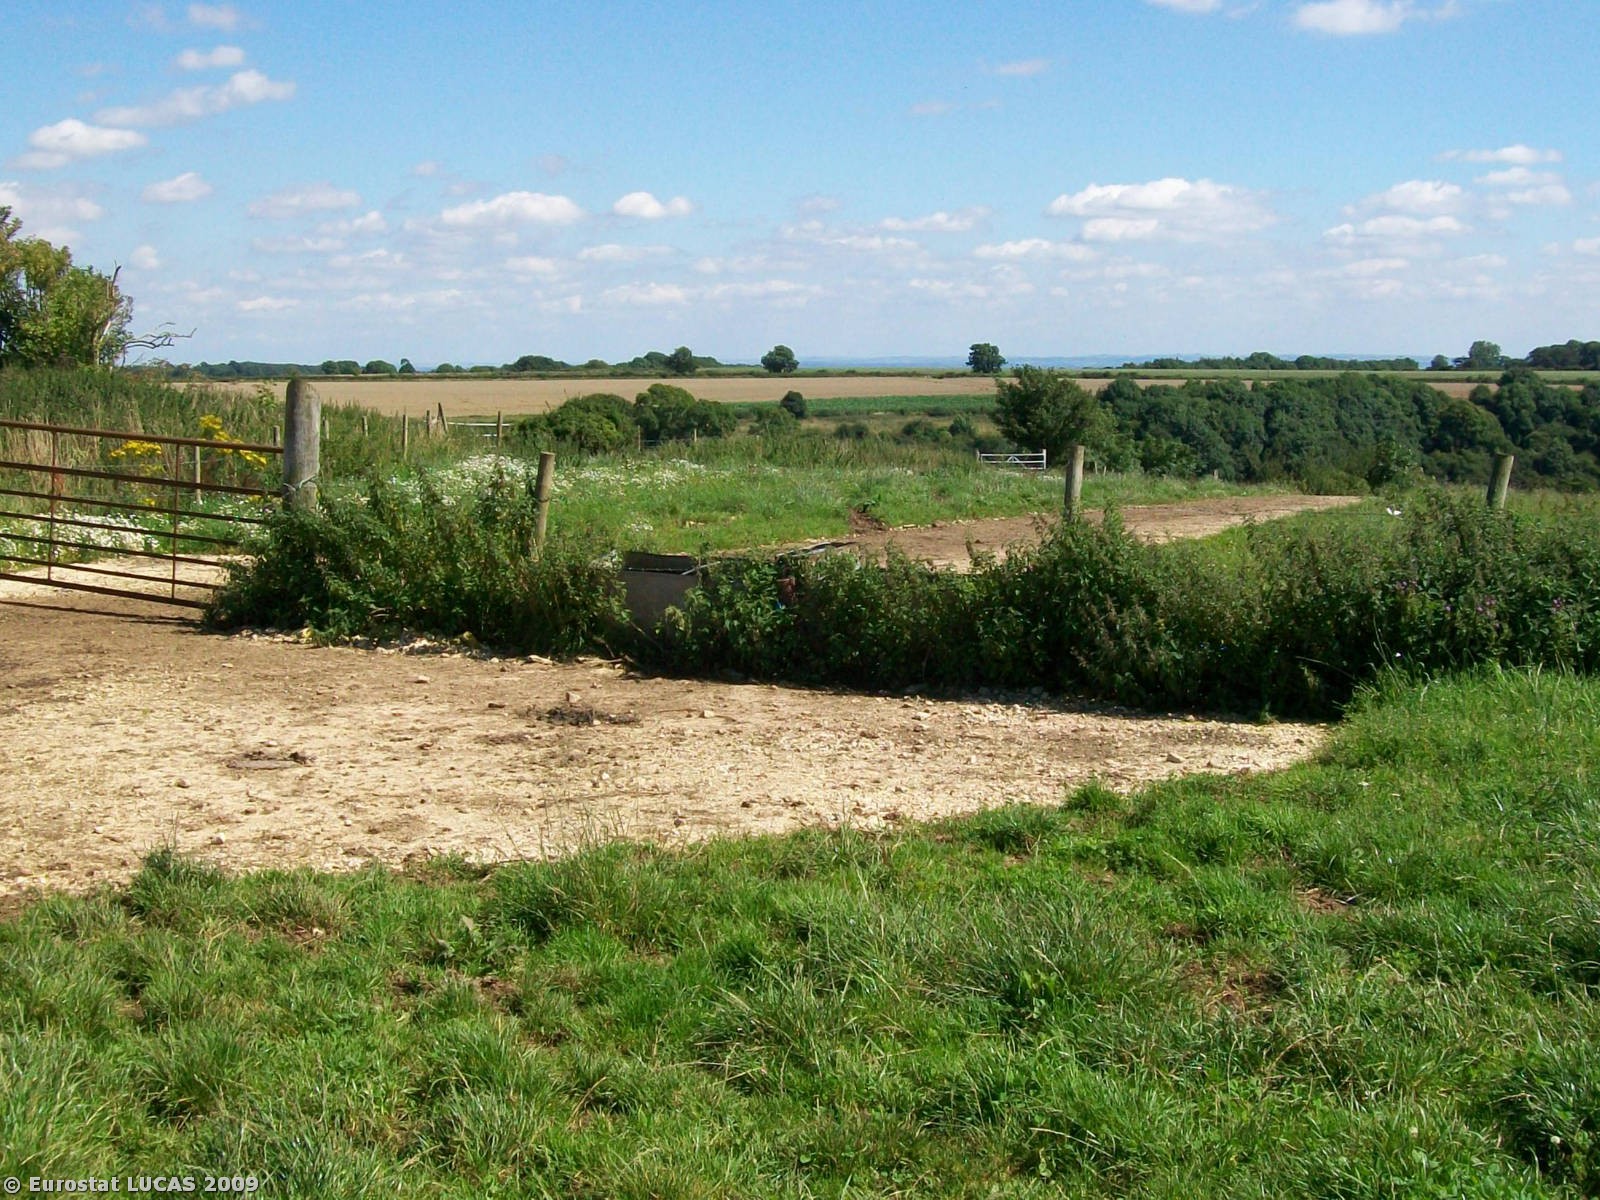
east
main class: Grassland
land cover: Grassland without tree/shrub cover
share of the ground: > 75 %
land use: Agriculture (excluding fallow land and kitchen gardens)
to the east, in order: Grassland without tree/shrub cover; Tracks; Fences; Spontaneously vegetated surfaces; Conifer hedges; Grassland without tree/shrub cover; Fences; Tracks; Grass margins; Grassland without tree/shrub cover
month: August
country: GB
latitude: 51.6612
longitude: -2.3081
